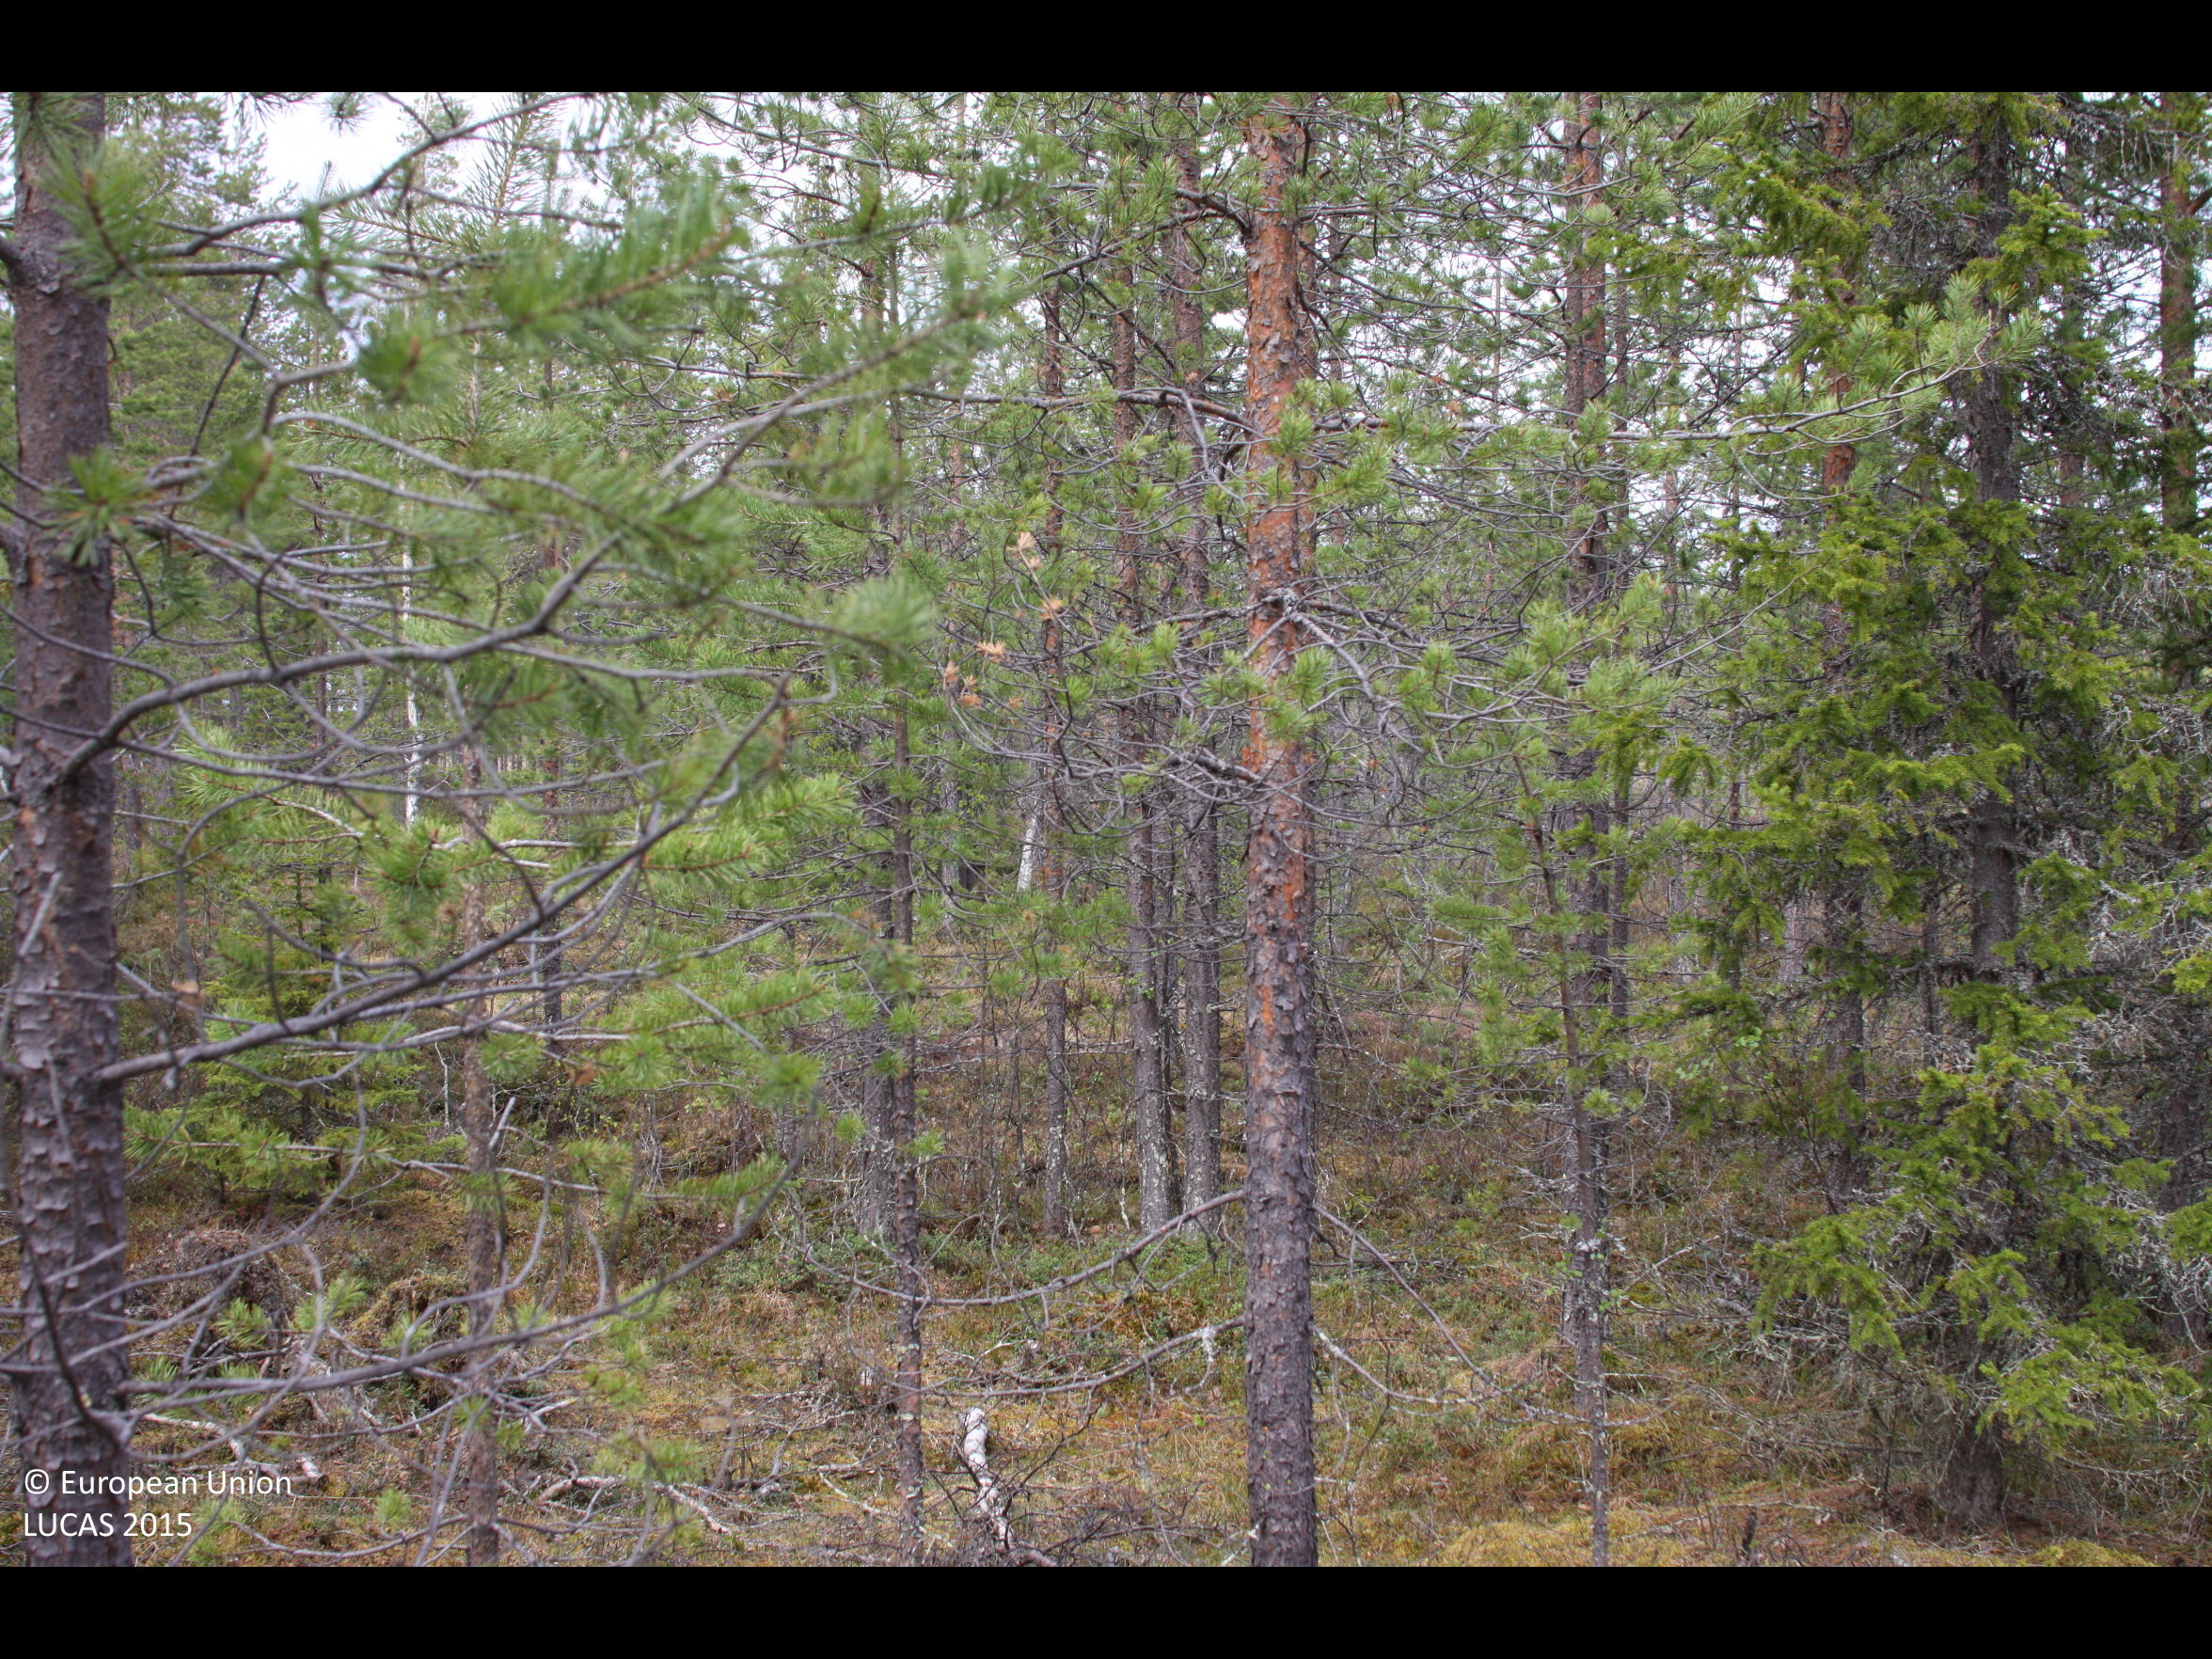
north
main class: Woodland
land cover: Pine dominated coniferous woodland
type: boreal forest
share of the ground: > 75 %
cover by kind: coniferous forest trees 70 %, shrubs 20 %, broadleaved forest trees 5 %, lichens and mosses 5 %
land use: Forestry
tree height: > 5 m
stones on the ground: < 10 %
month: June
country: FI
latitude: 66.1751
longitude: 27.8104
